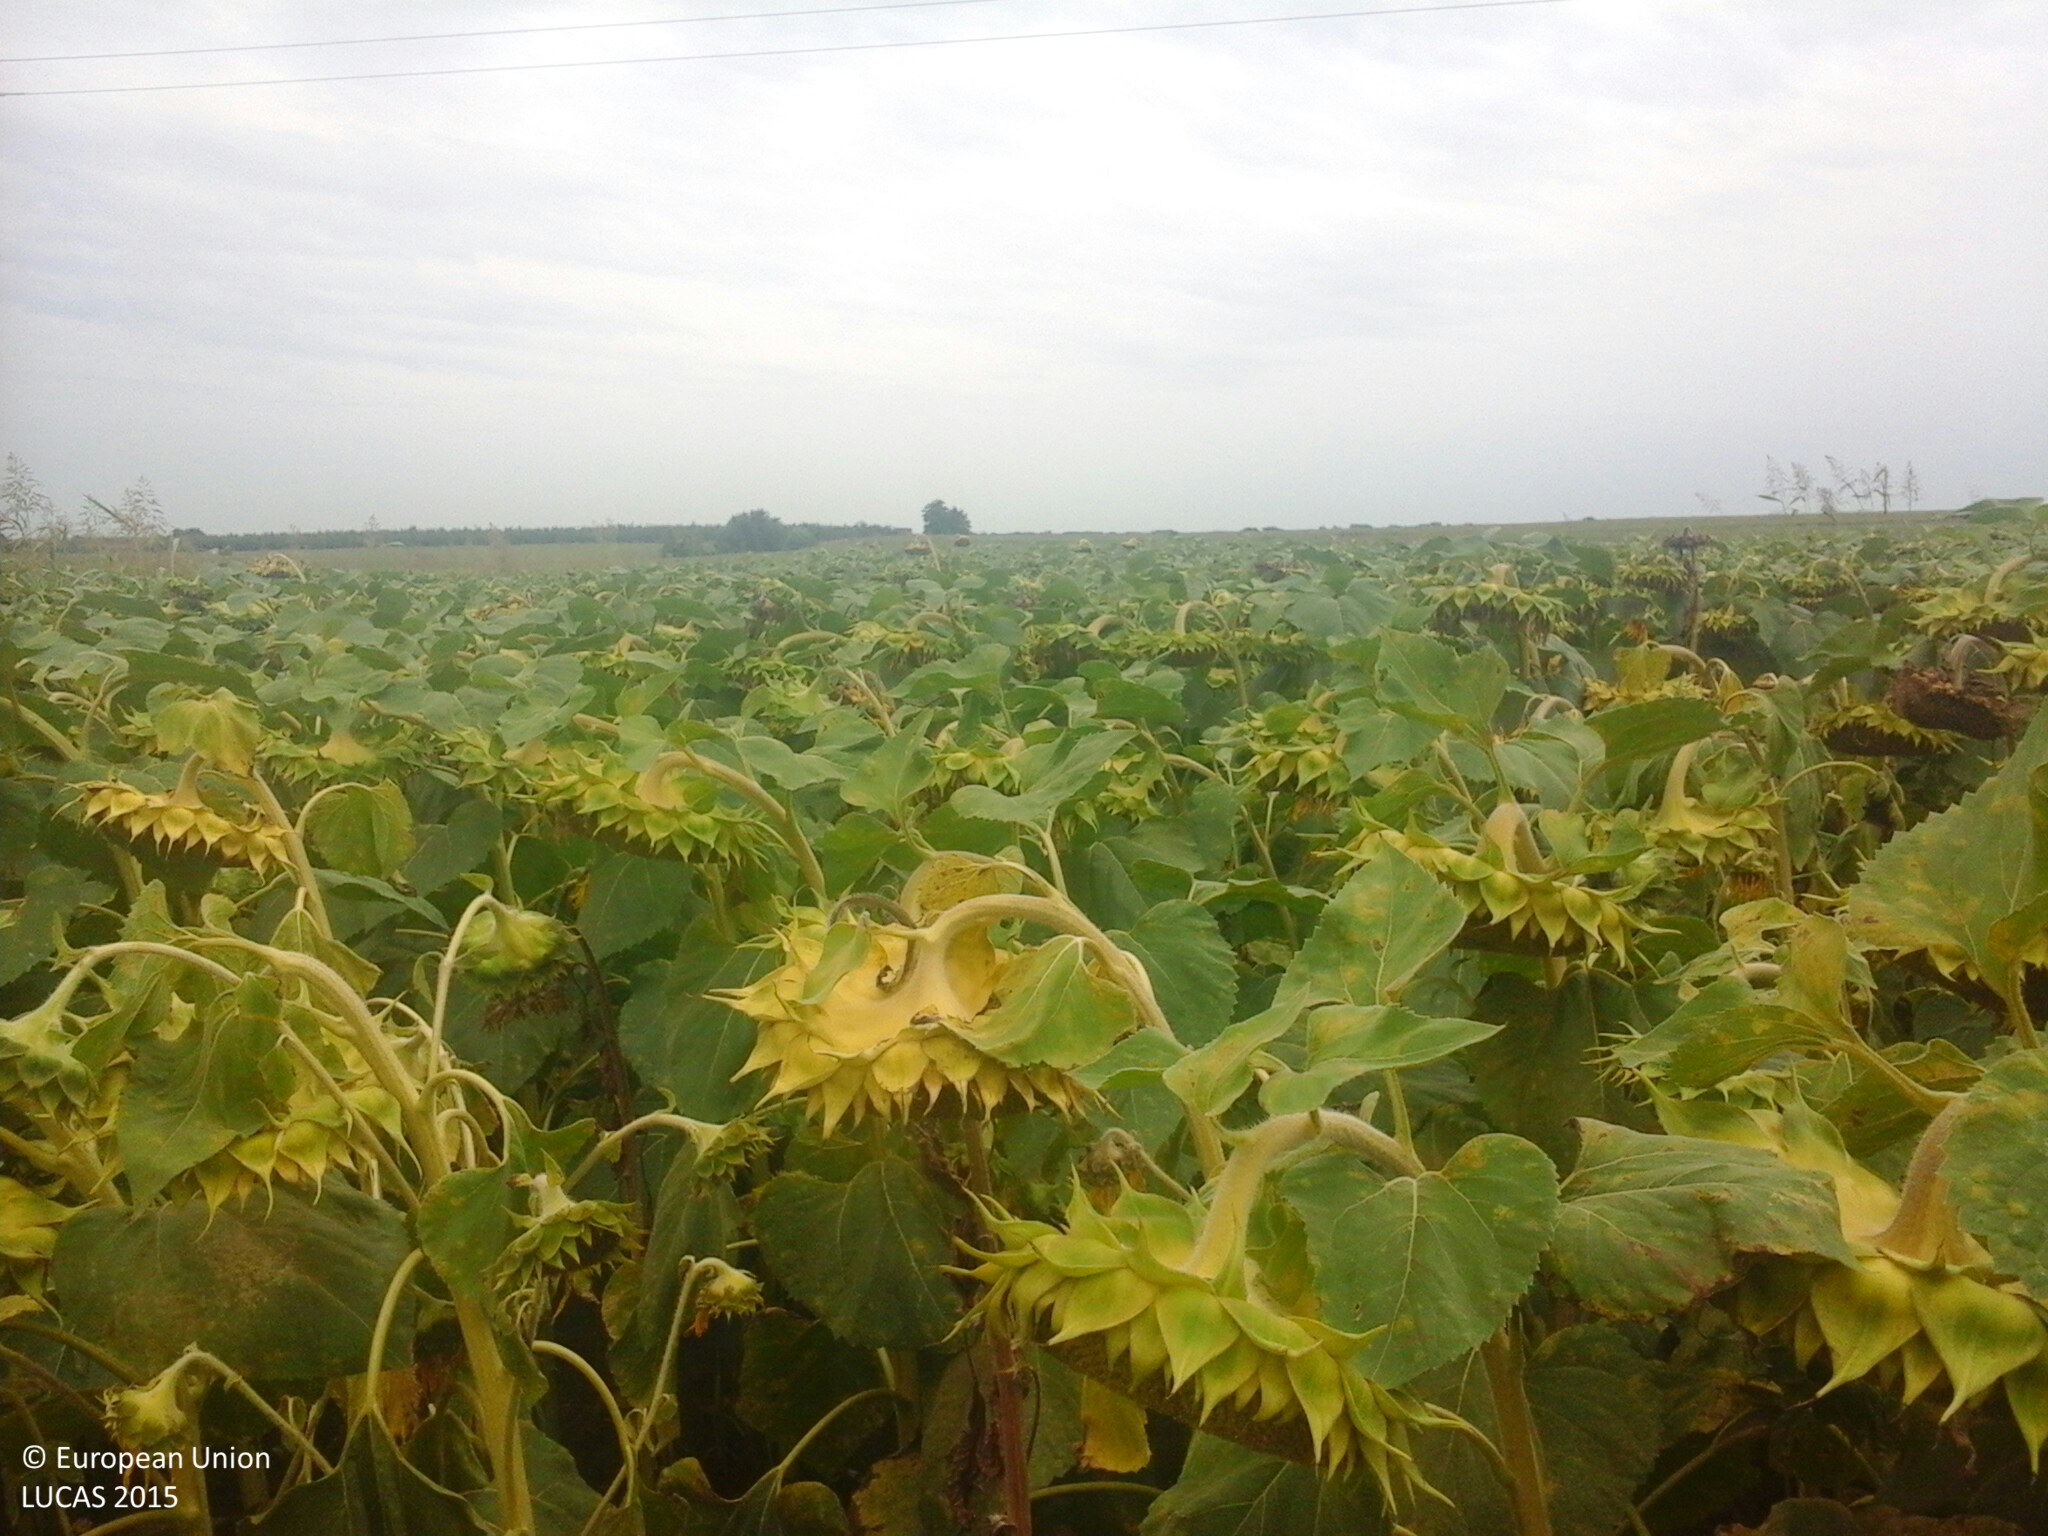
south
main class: Cropland
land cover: Sunflower
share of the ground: > 75 %
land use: Agriculture (excluding fallow land and kitchen gardens)
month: July
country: HU
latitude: 47.0125
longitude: 18.4437
